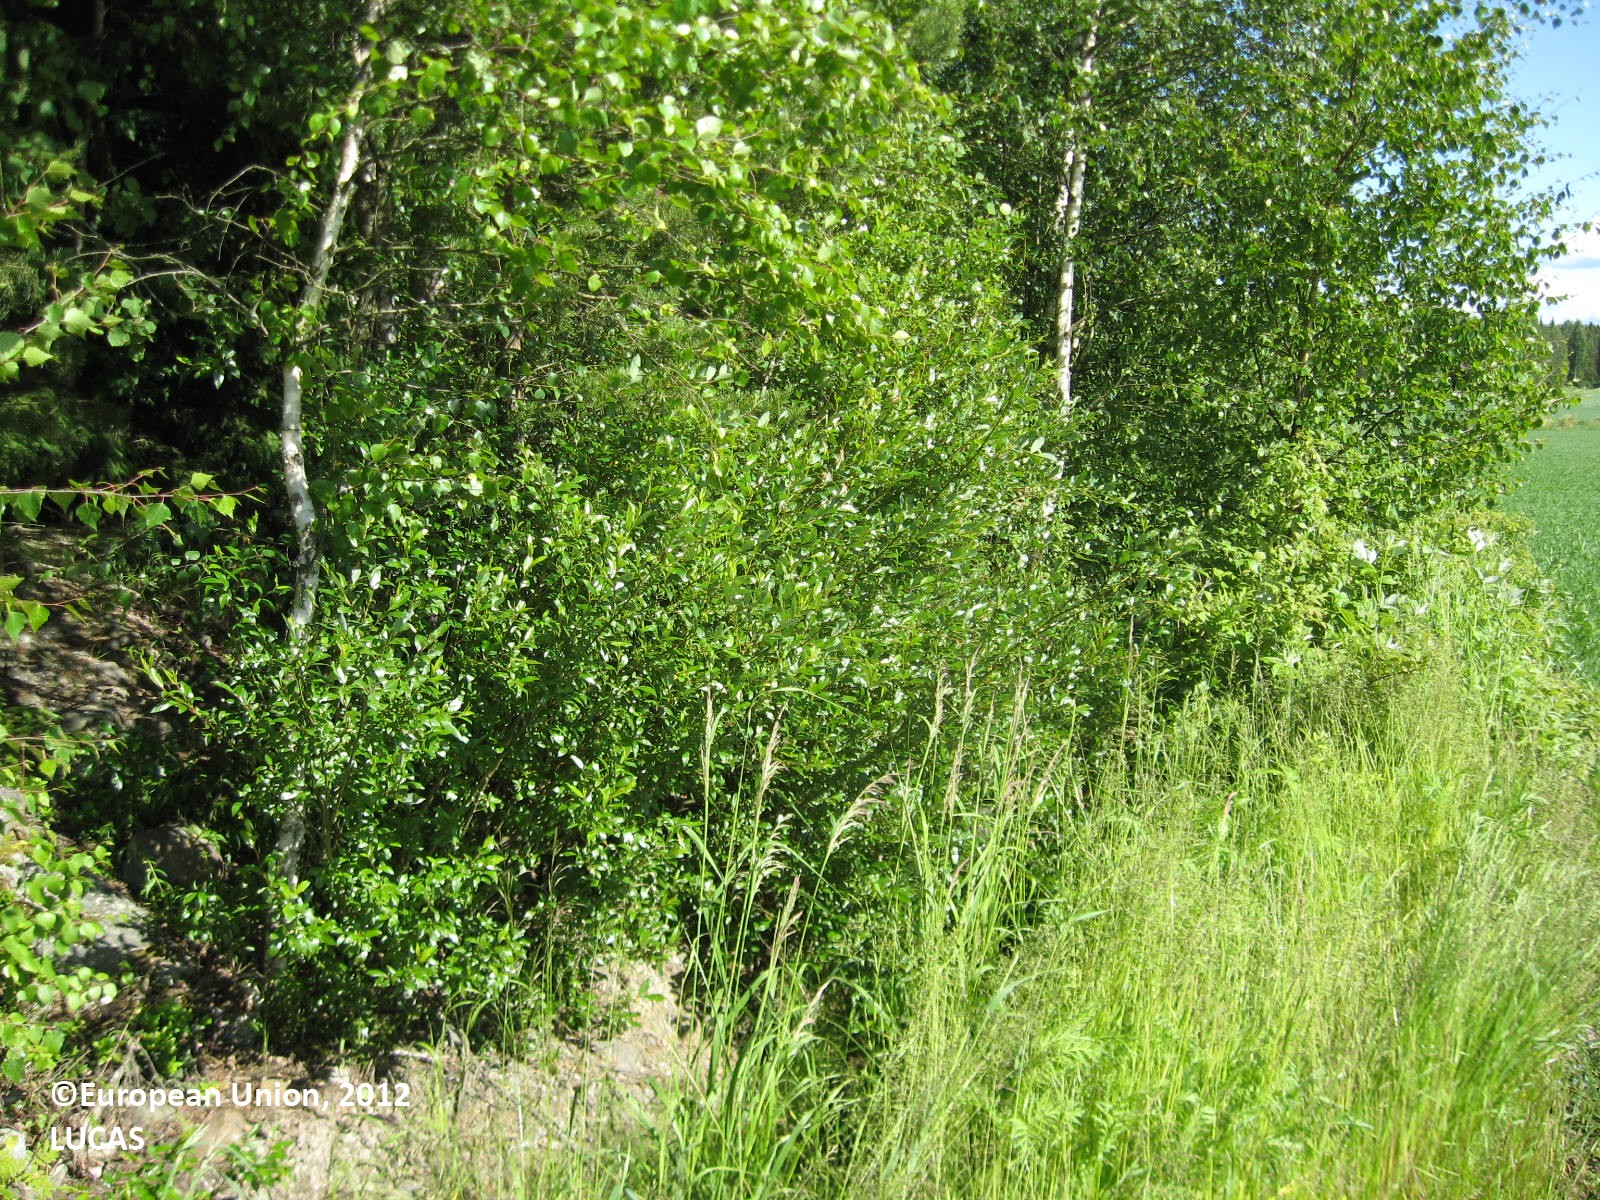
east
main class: Cropland
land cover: Barley
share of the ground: > 75 %
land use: Agriculture (excluding fallow land and kitchen gardens)
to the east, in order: Barley; Electric lines; Barley; Shruby margins; Ditches and canals; Broadleaved woodland; Shruby margins; Ditches and canals; Barley
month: June
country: FI
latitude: 62.8248
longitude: 22.6751
